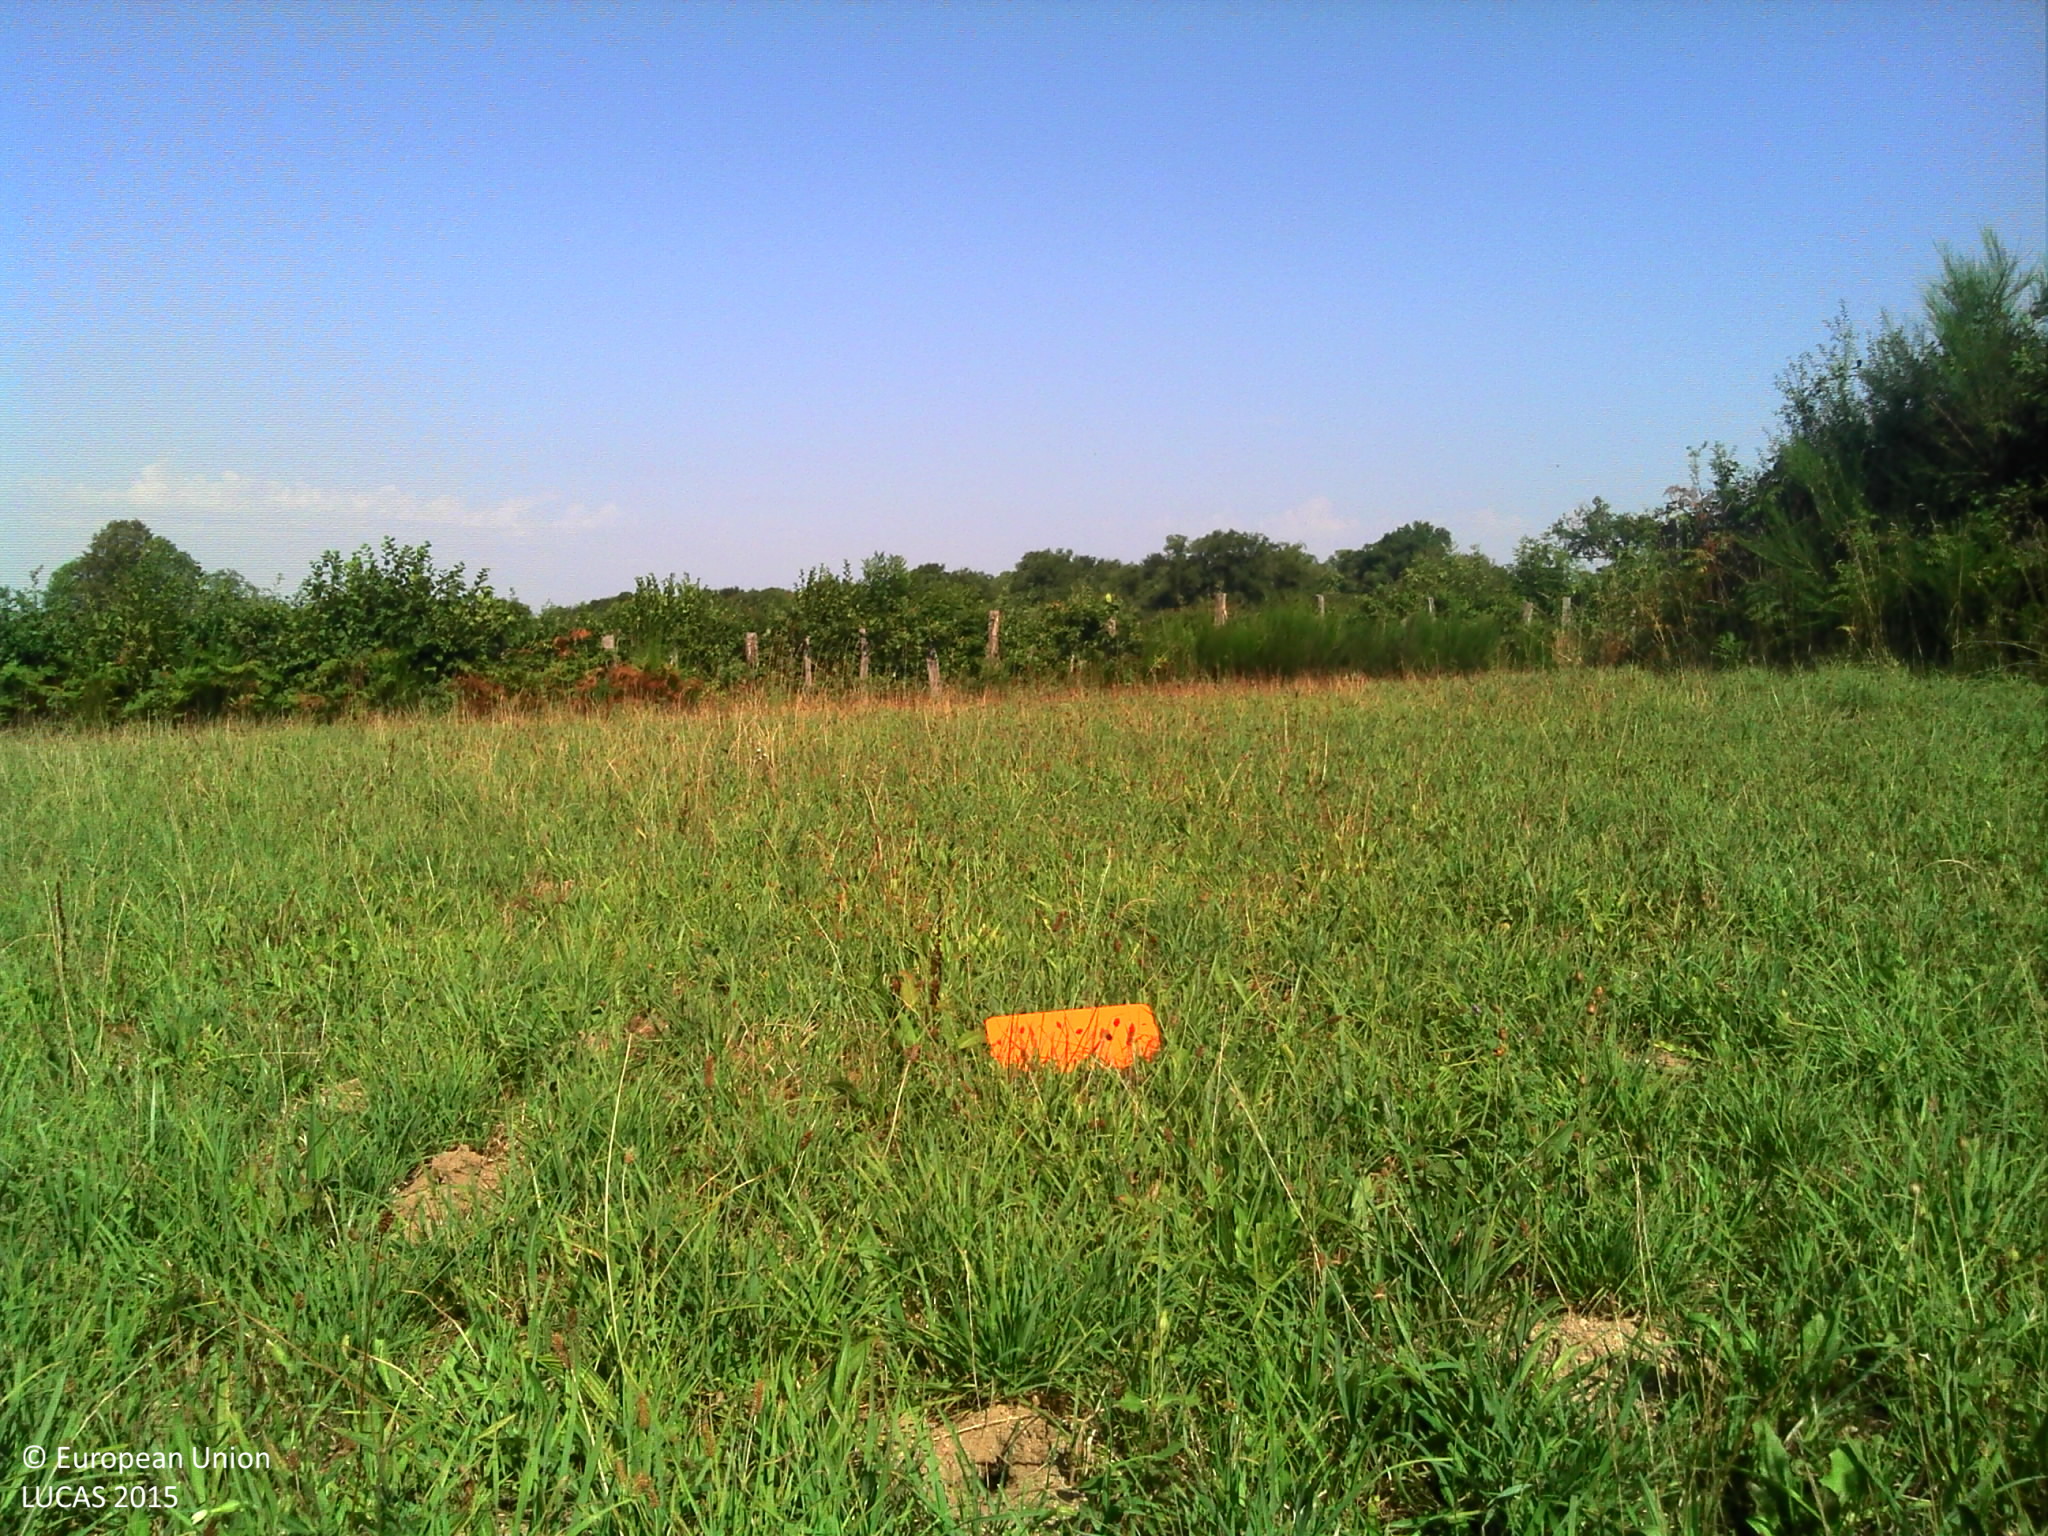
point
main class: Cropland
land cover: Temporary grasslands
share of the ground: > 75 %
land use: Agriculture (excluding fallow land and kitchen gardens)
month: August
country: FR
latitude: 46.2239
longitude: 1.6553
